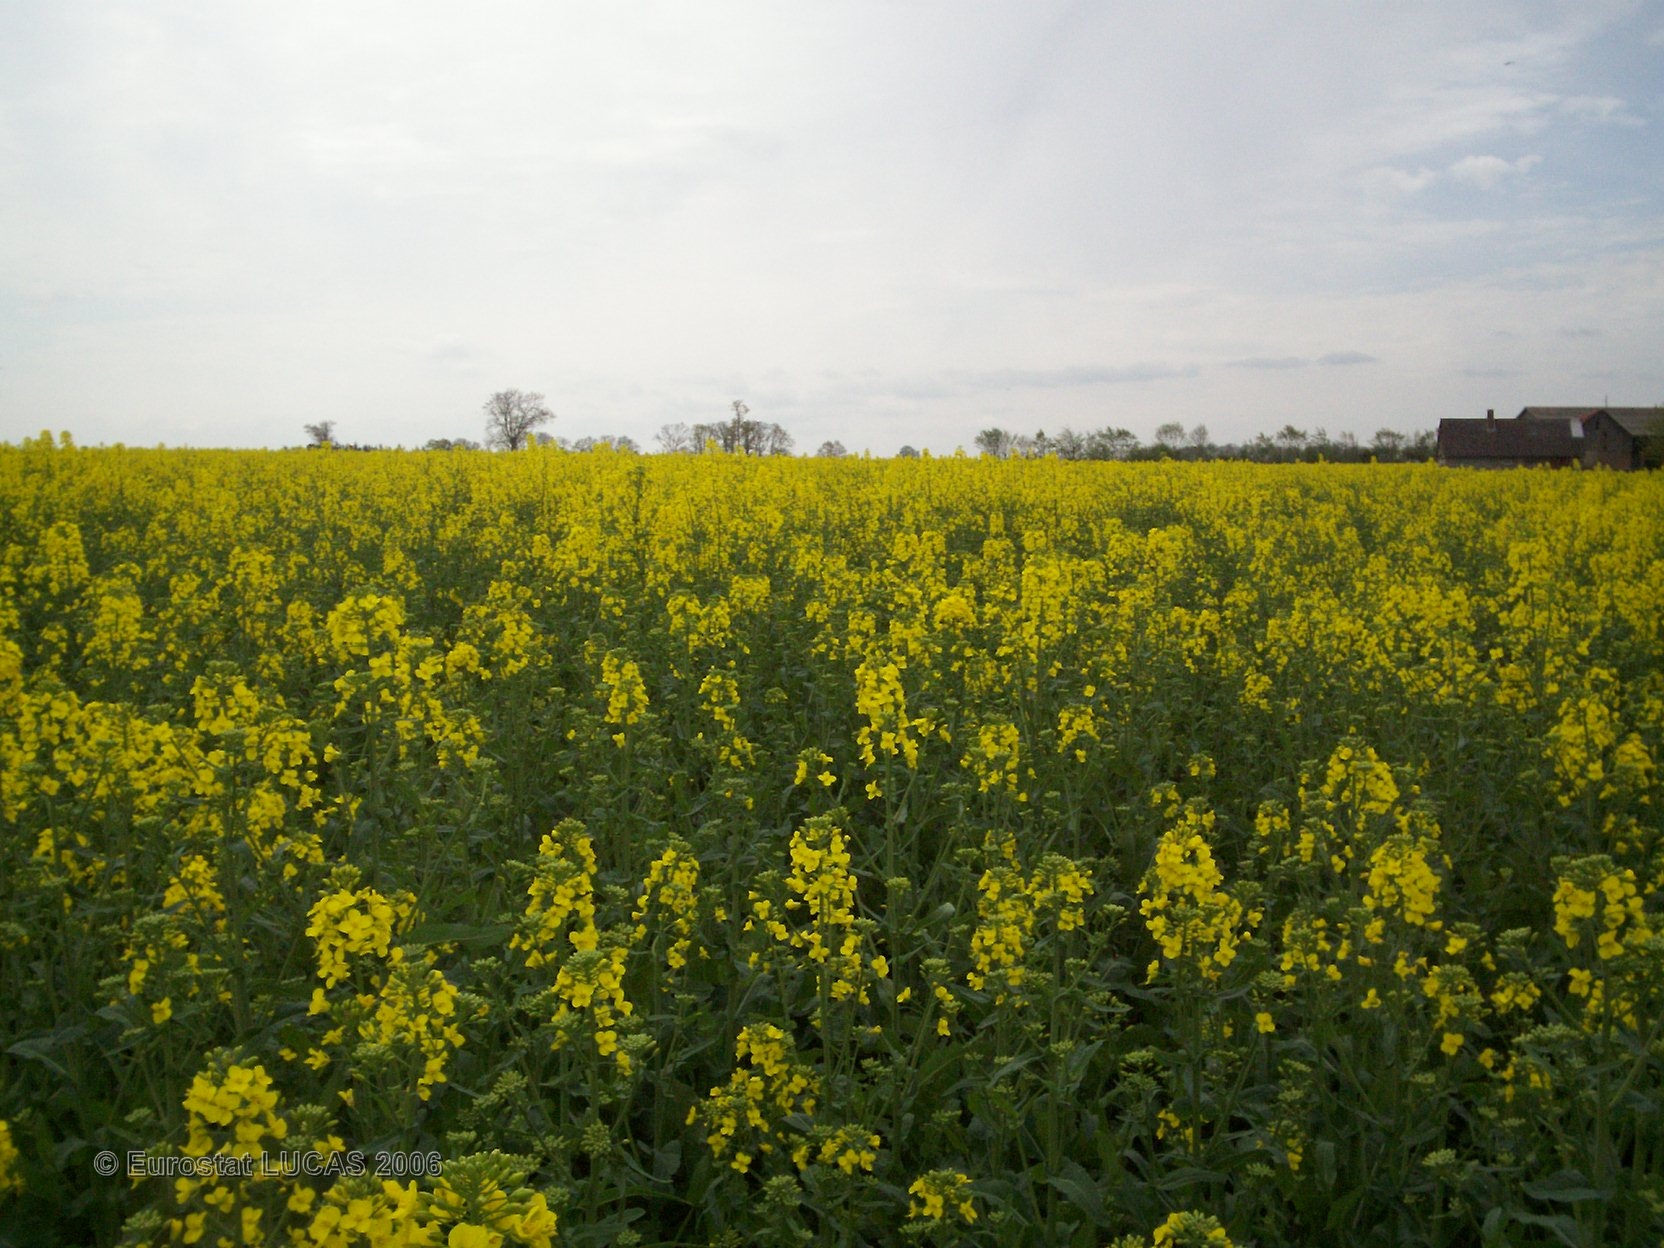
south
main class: Cropland
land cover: Rape and turnip rape
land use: Agriculture (excluding fallow land and kitchen gardens)
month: May
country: FR
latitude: 48.8856
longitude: 0.5512
